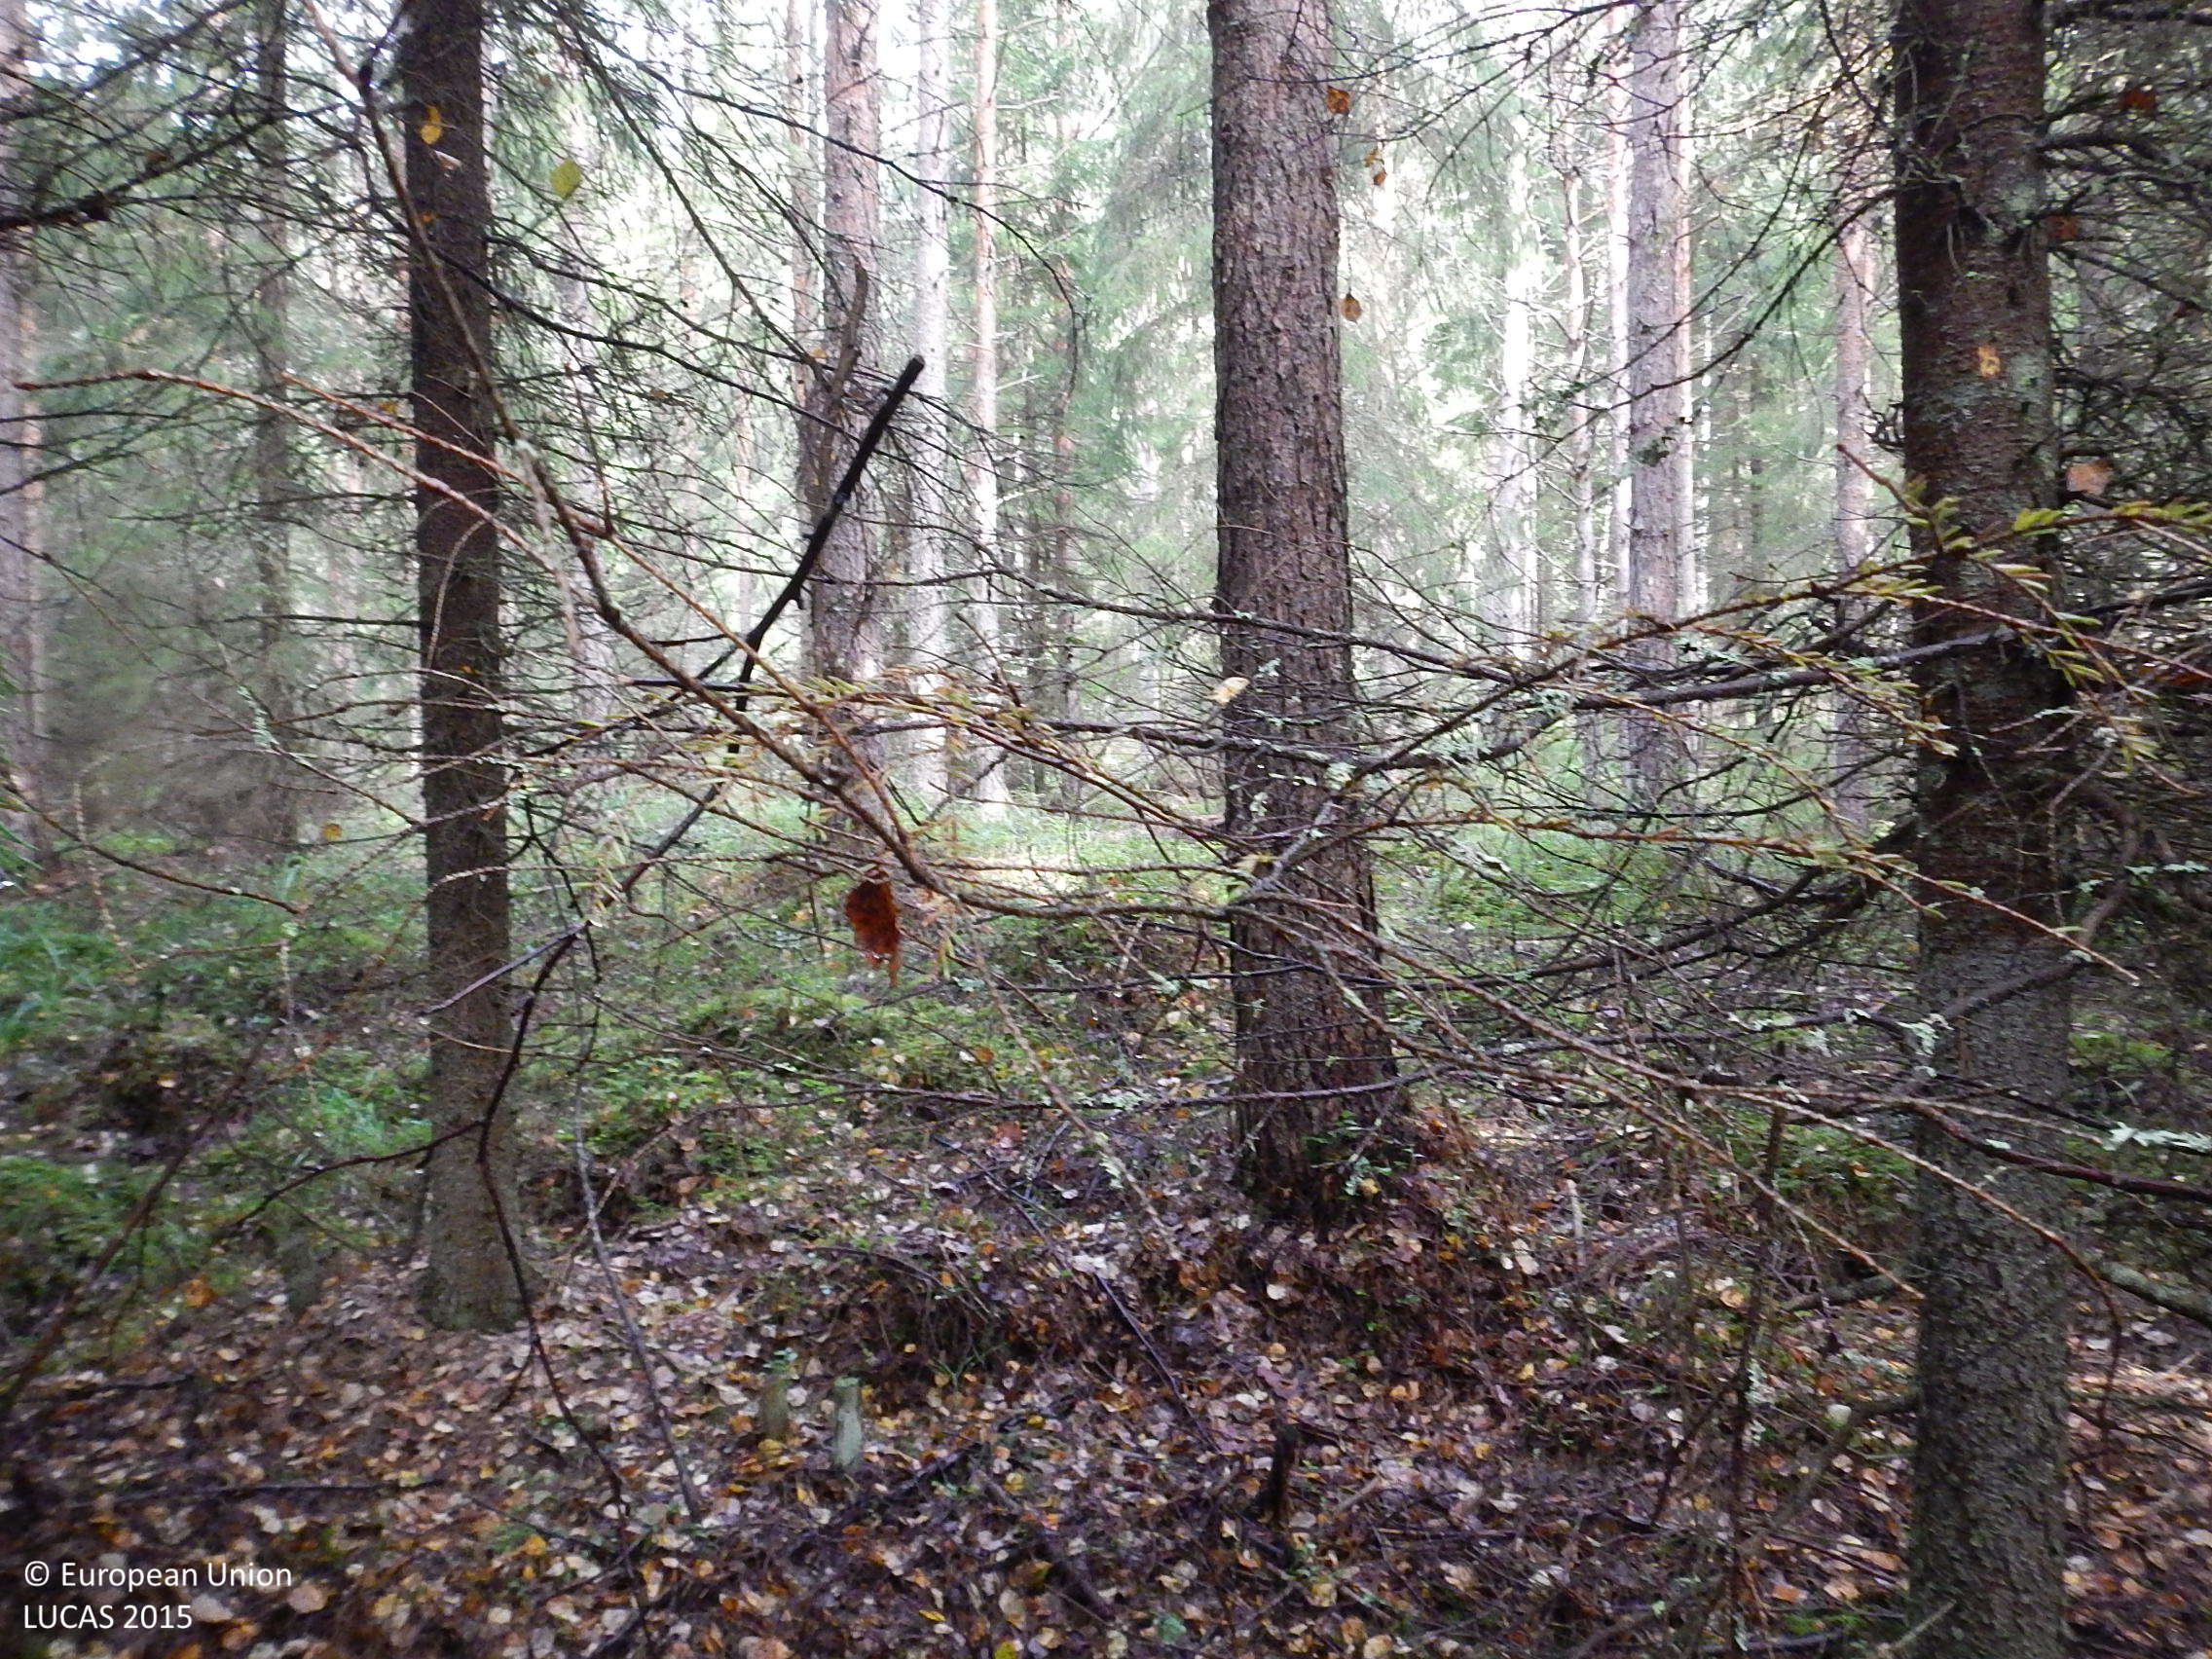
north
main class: Woodland
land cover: Other mixed woodland
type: boreal forest
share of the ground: > 75 %
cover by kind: coniferous forest trees 50 %, broadleaved forest trees 25 %, shrubs 10 %, unconsolidated bare surface 10 %, lichens and mosses 5 %
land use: Forestry
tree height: > 5 m
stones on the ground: 10 - 25 %
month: September
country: FI
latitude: 61.4148
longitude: 22.2575
